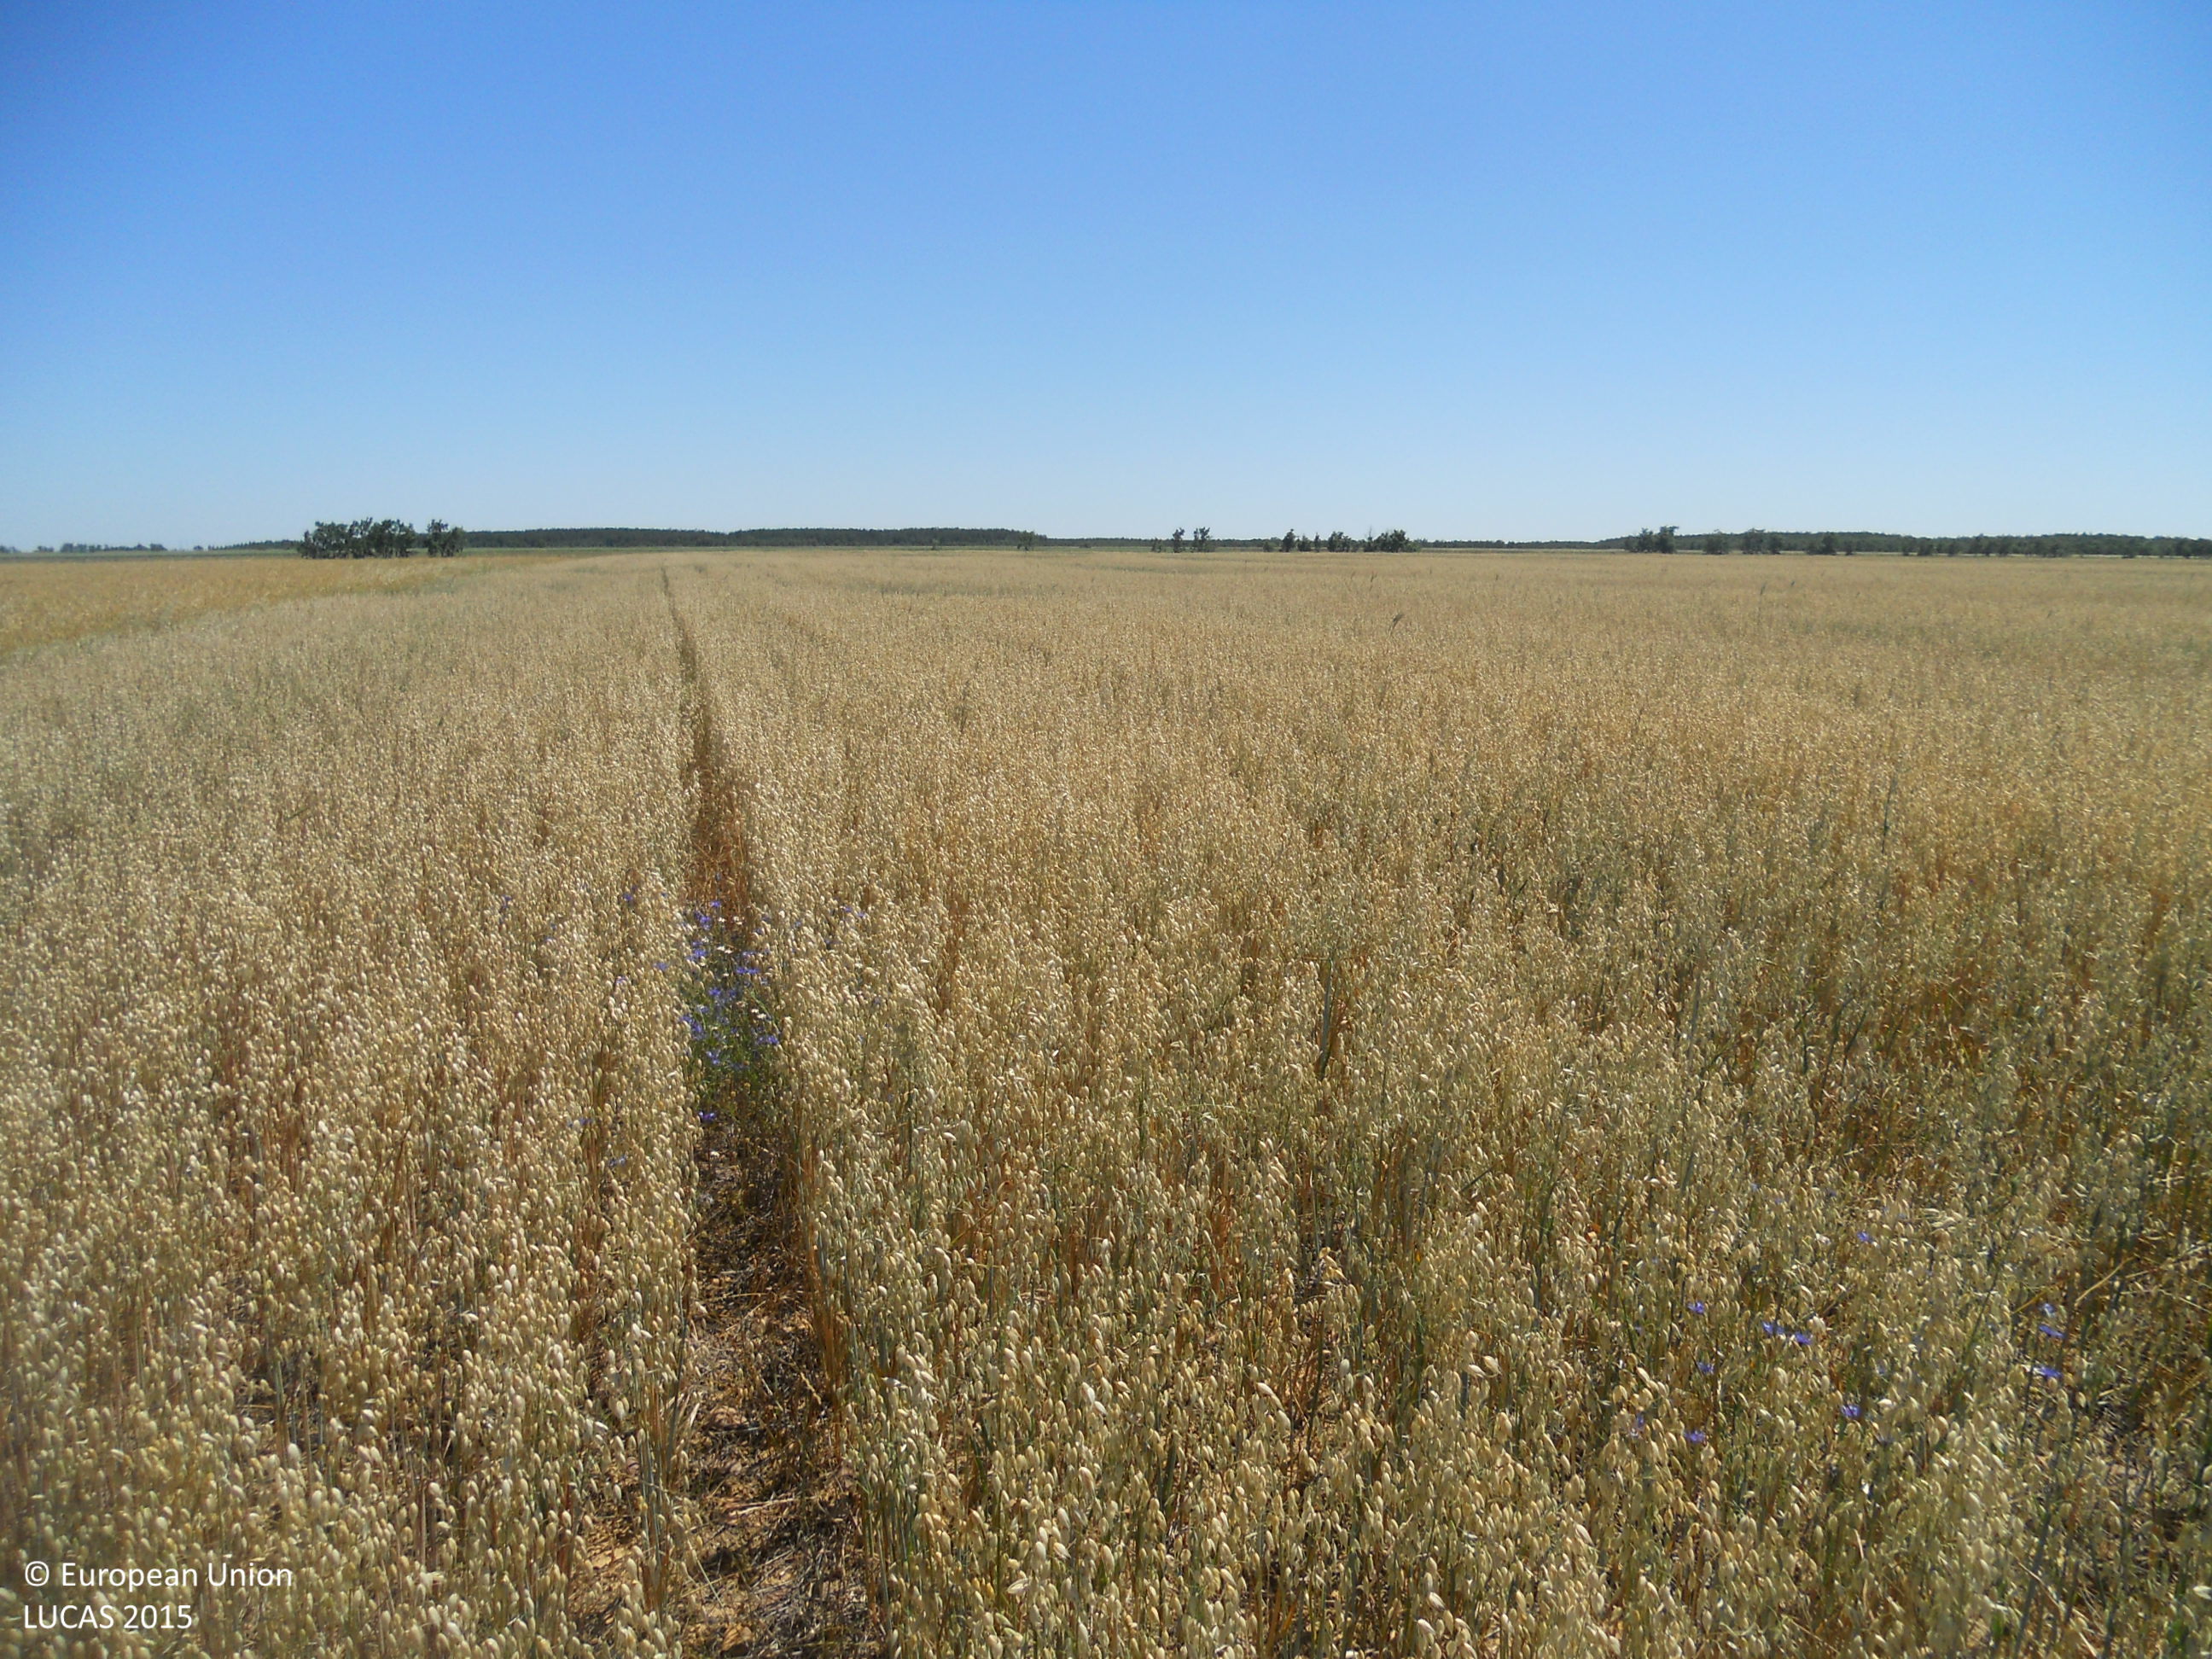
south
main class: Cropland
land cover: Oats
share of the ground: > 75 %
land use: Agriculture (excluding fallow land and kitchen gardens)
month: June
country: ES
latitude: 42.4323
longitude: -4.8497
